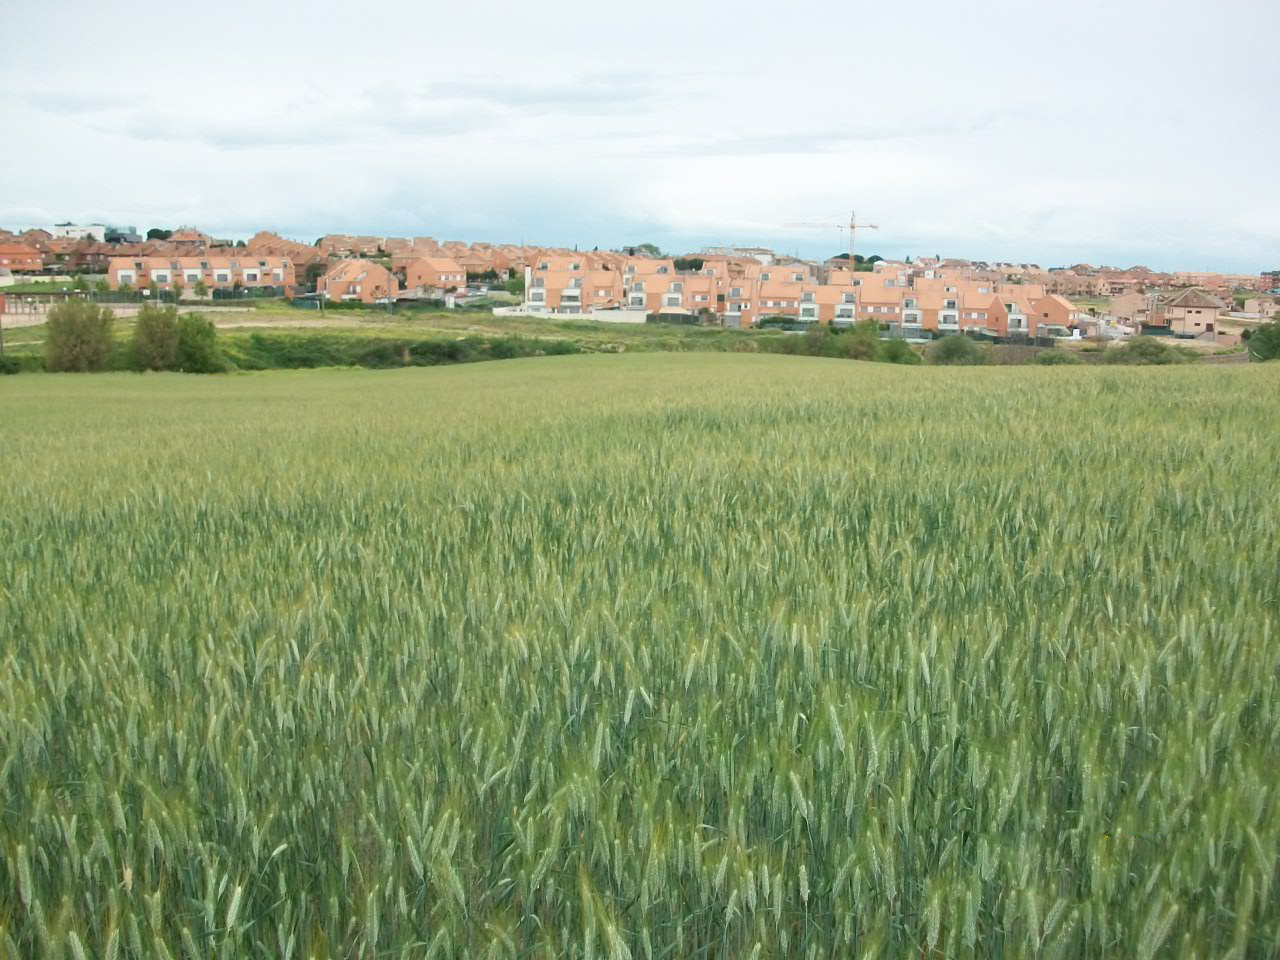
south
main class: Cropland
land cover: Common wheat
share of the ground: > 75 %
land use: Agriculture (excluding fallow land and kitchen gardens)
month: April
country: ES
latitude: 40.2686
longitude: -3.8550
